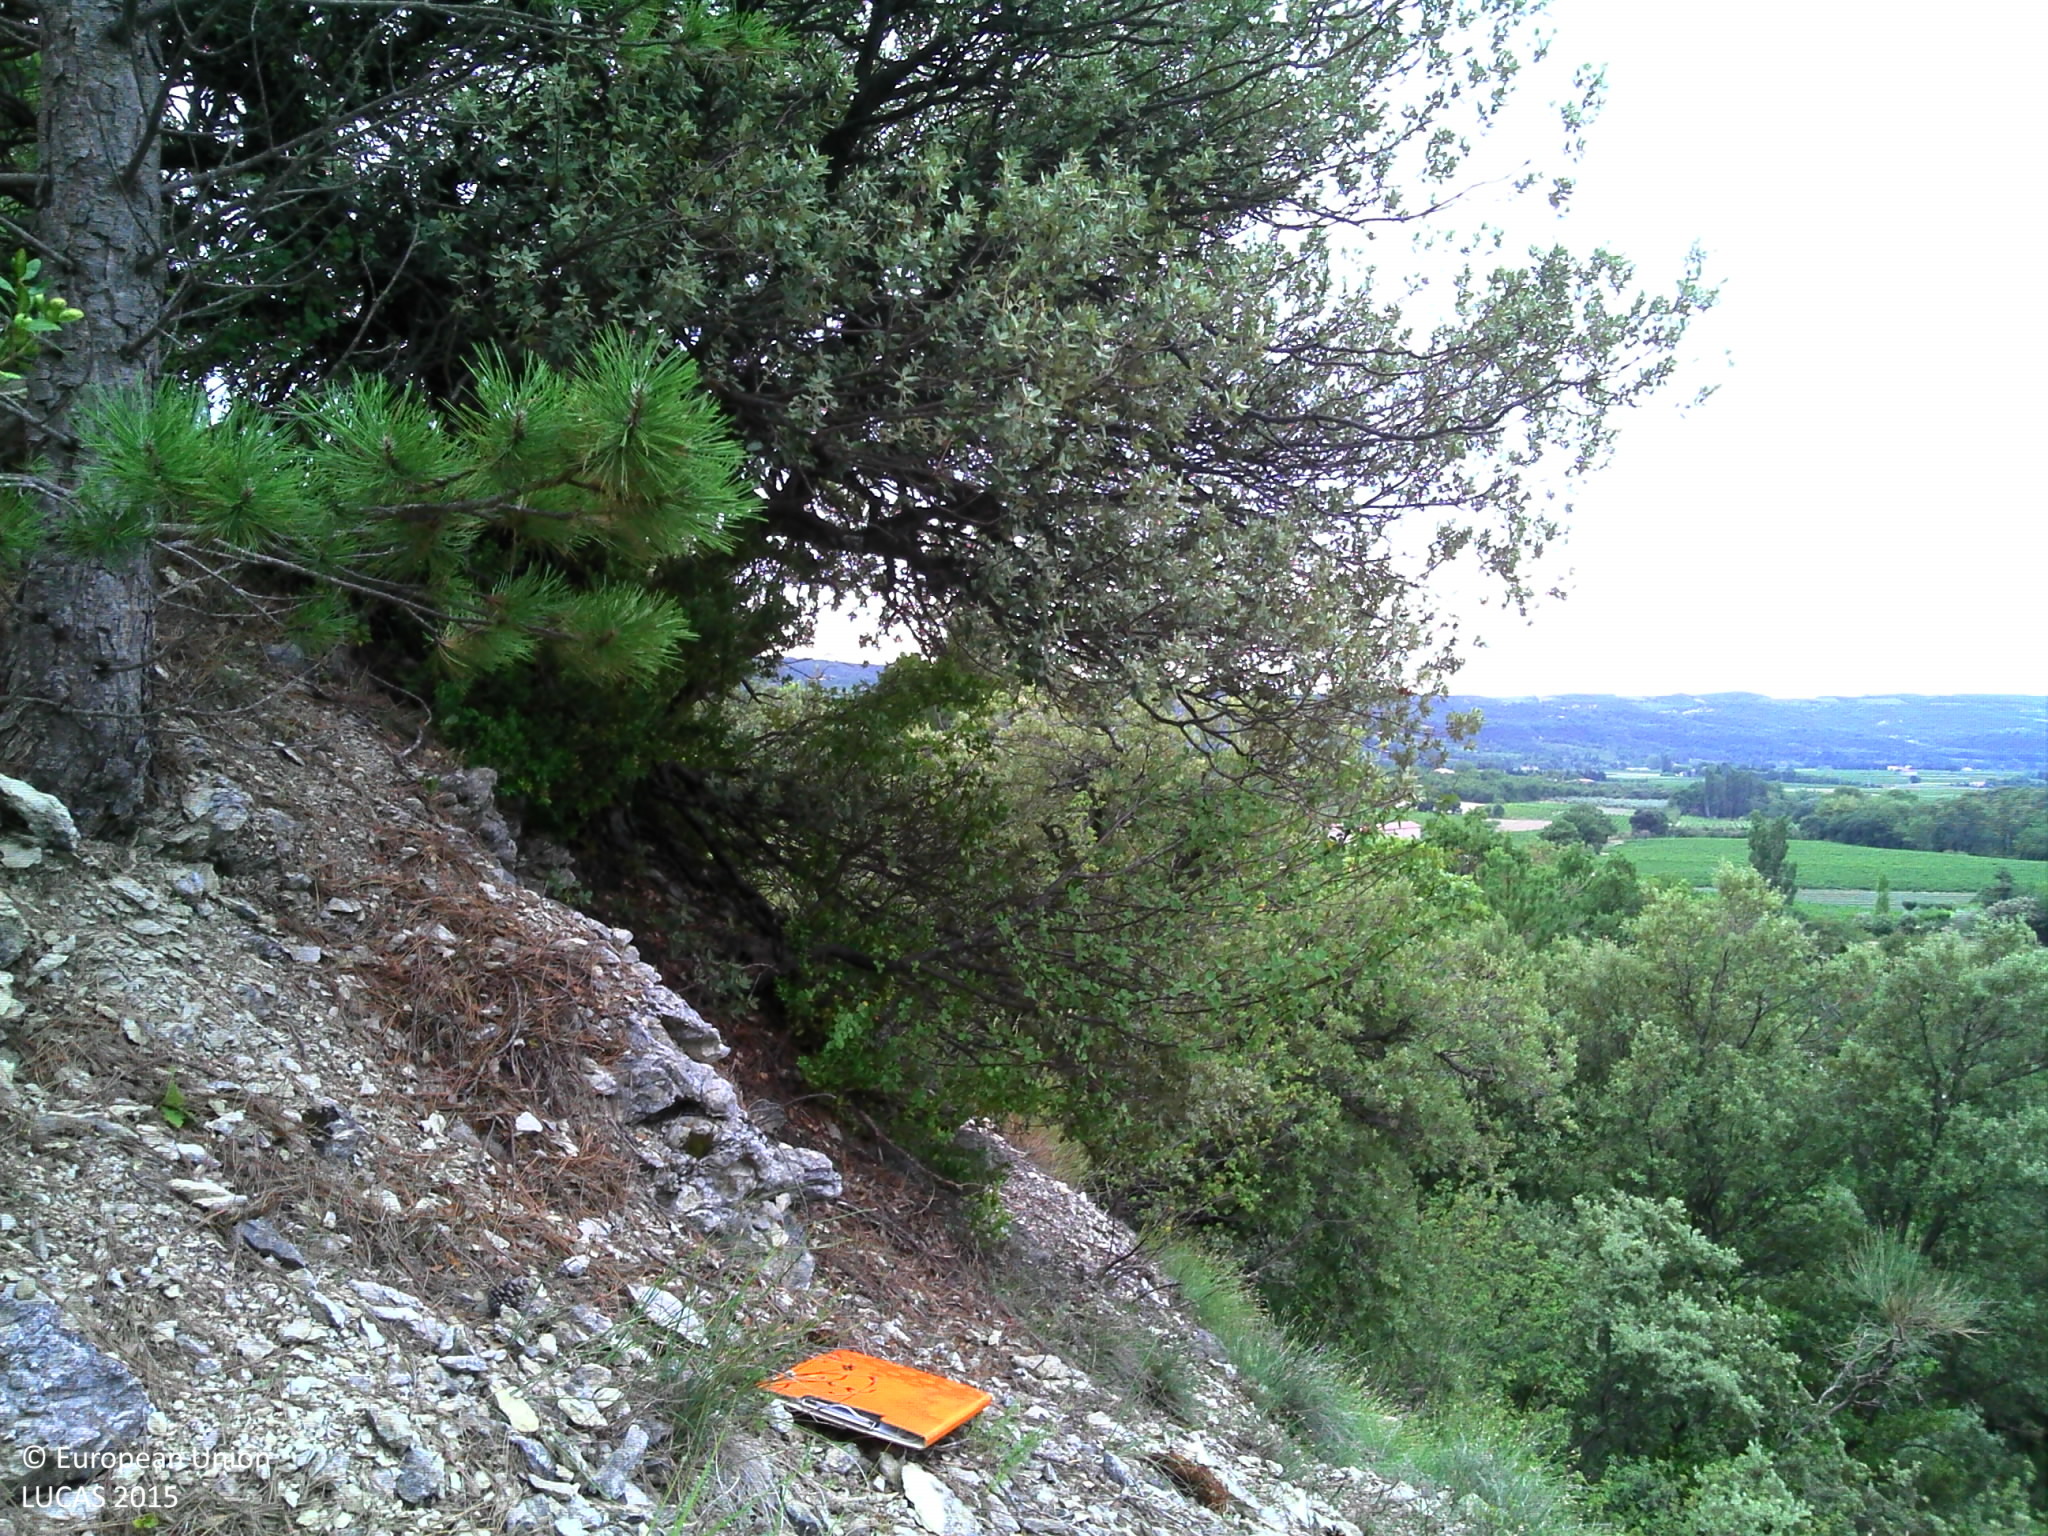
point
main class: Shrubland
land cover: Shrubland with sparse tree cover
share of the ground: > 75 %
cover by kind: shrubs 95 %, coniferous forest trees 5 %
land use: Semi-natural and natural areas not in use
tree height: < 5 m
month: September
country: FR
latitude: 44.4141
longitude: 5.0717
